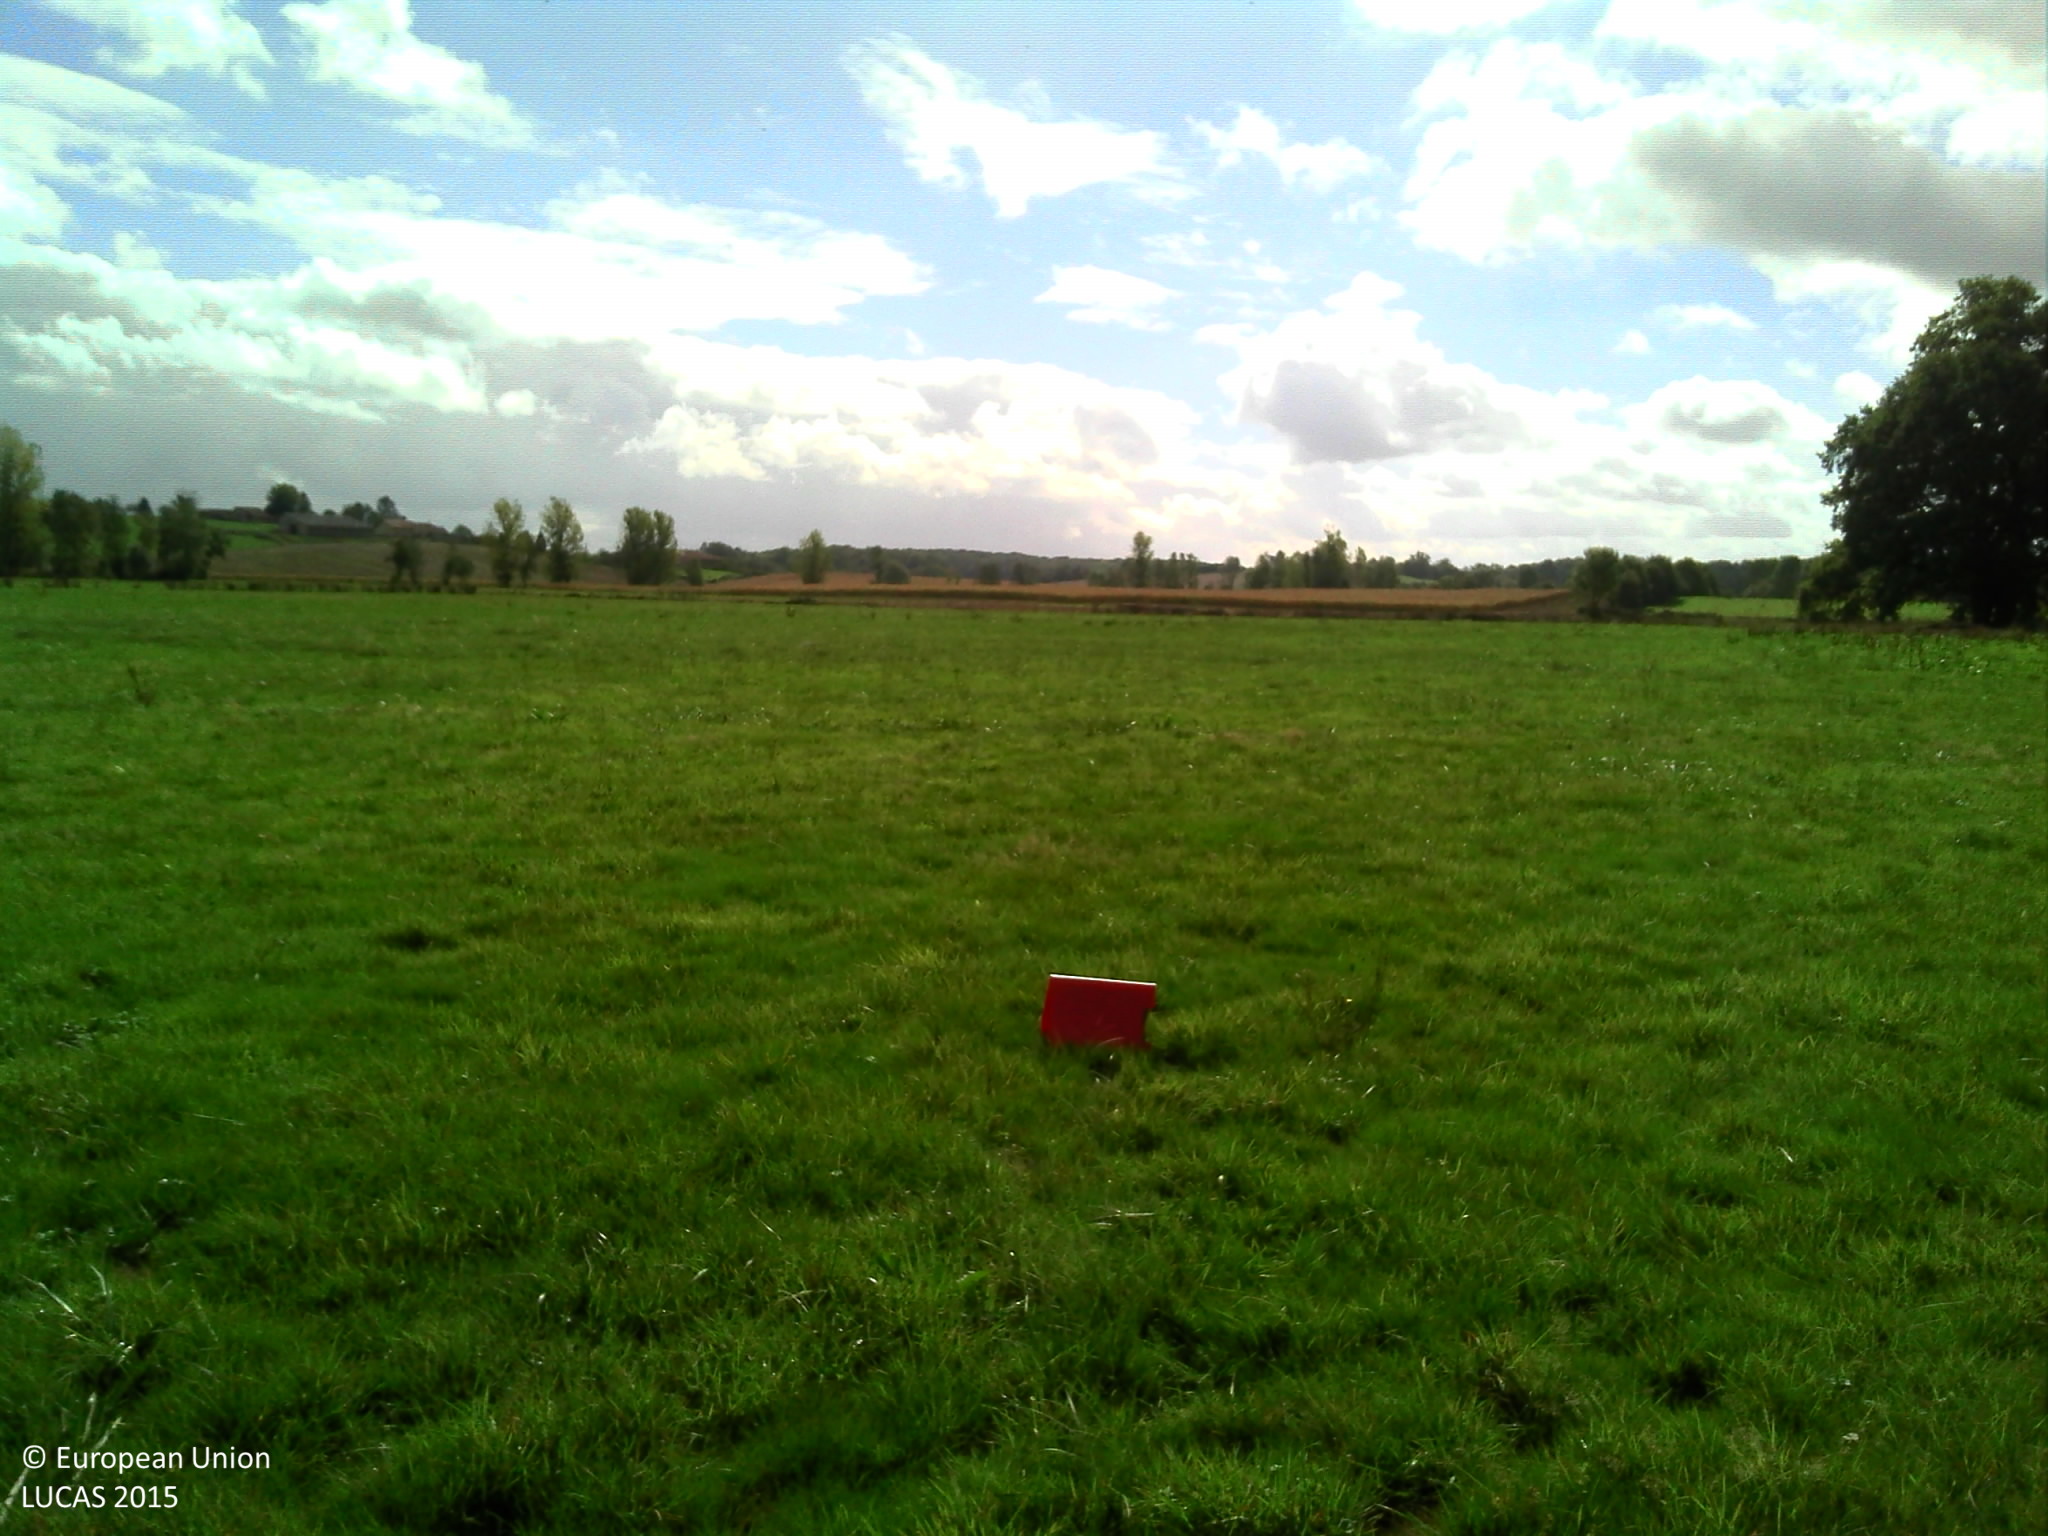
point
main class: Cropland
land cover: Temporary grasslands
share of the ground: > 75 %
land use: Agriculture (excluding fallow land and kitchen gardens)
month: October
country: FR
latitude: 46.4094
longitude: 5.2805
